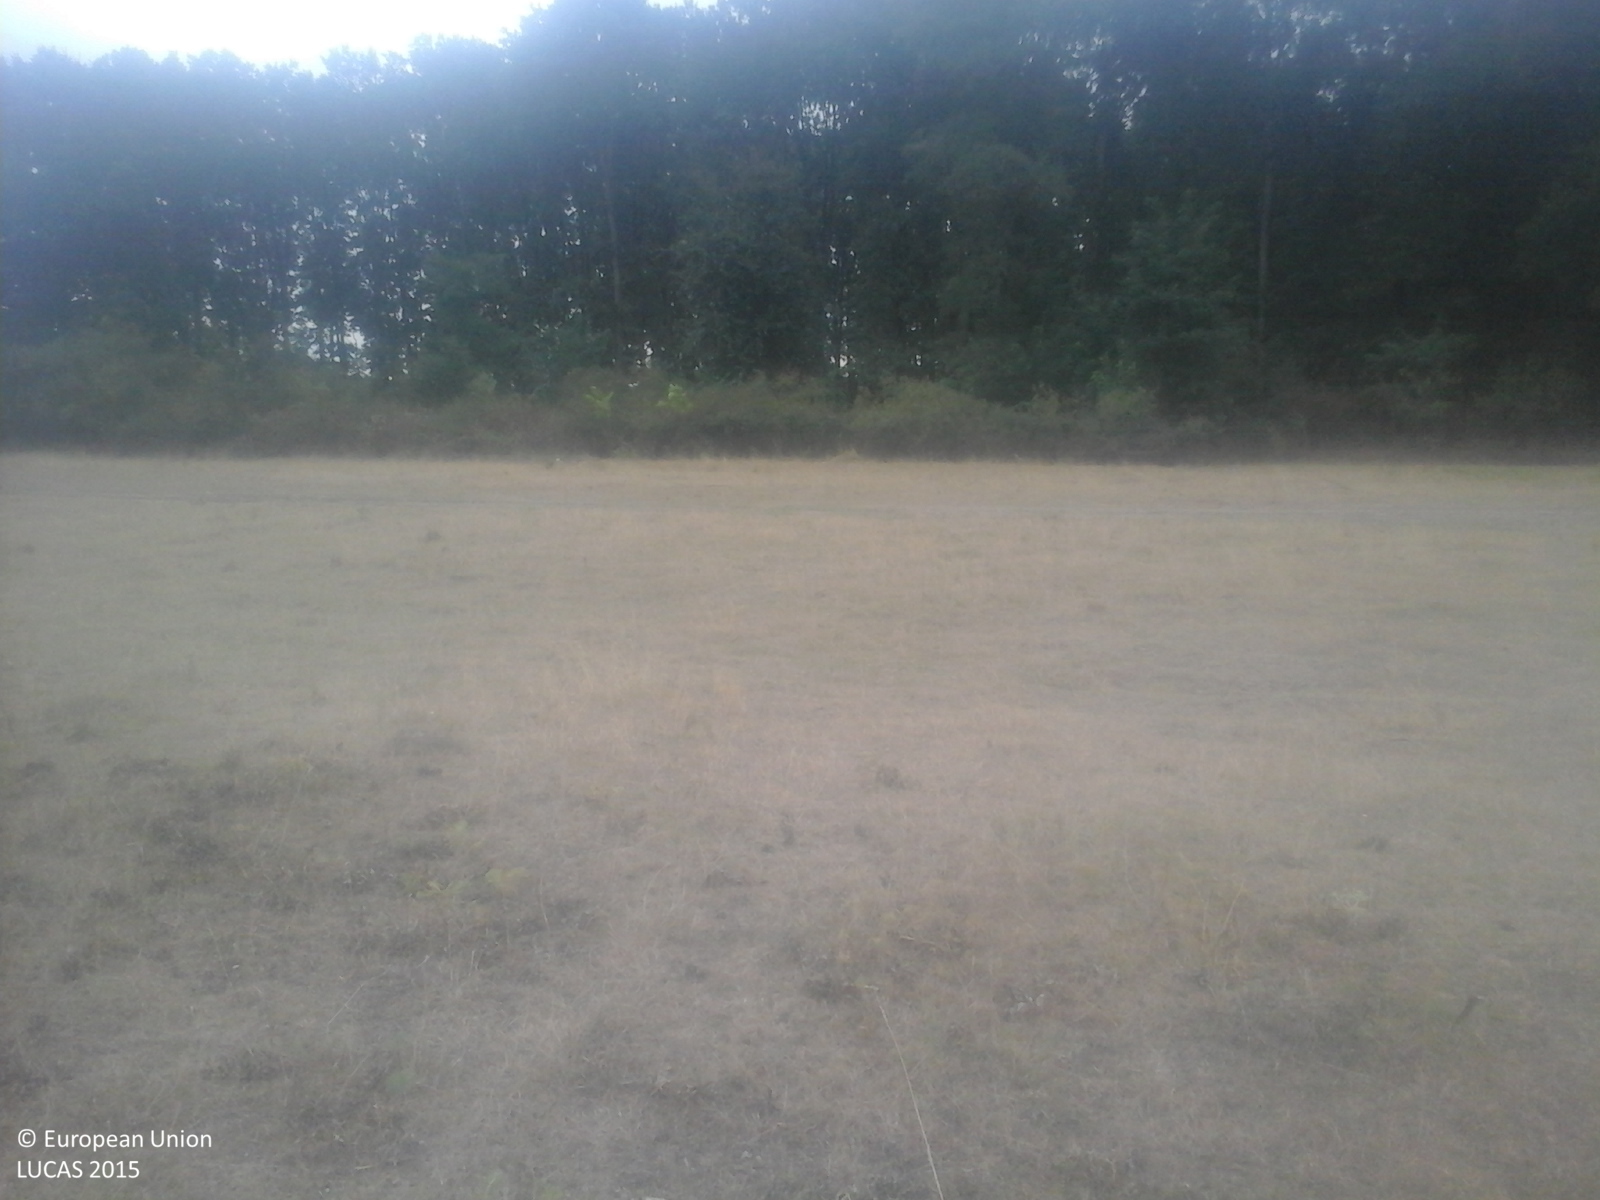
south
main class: Grassland
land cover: Grassland without tree/shrub cover
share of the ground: > 75 %
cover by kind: herbaceous plants 100 %
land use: Agriculture (excluding fallow land and kitchen gardens)
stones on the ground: < 10 %
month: September
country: RO
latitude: 47.7031
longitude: 22.7082
